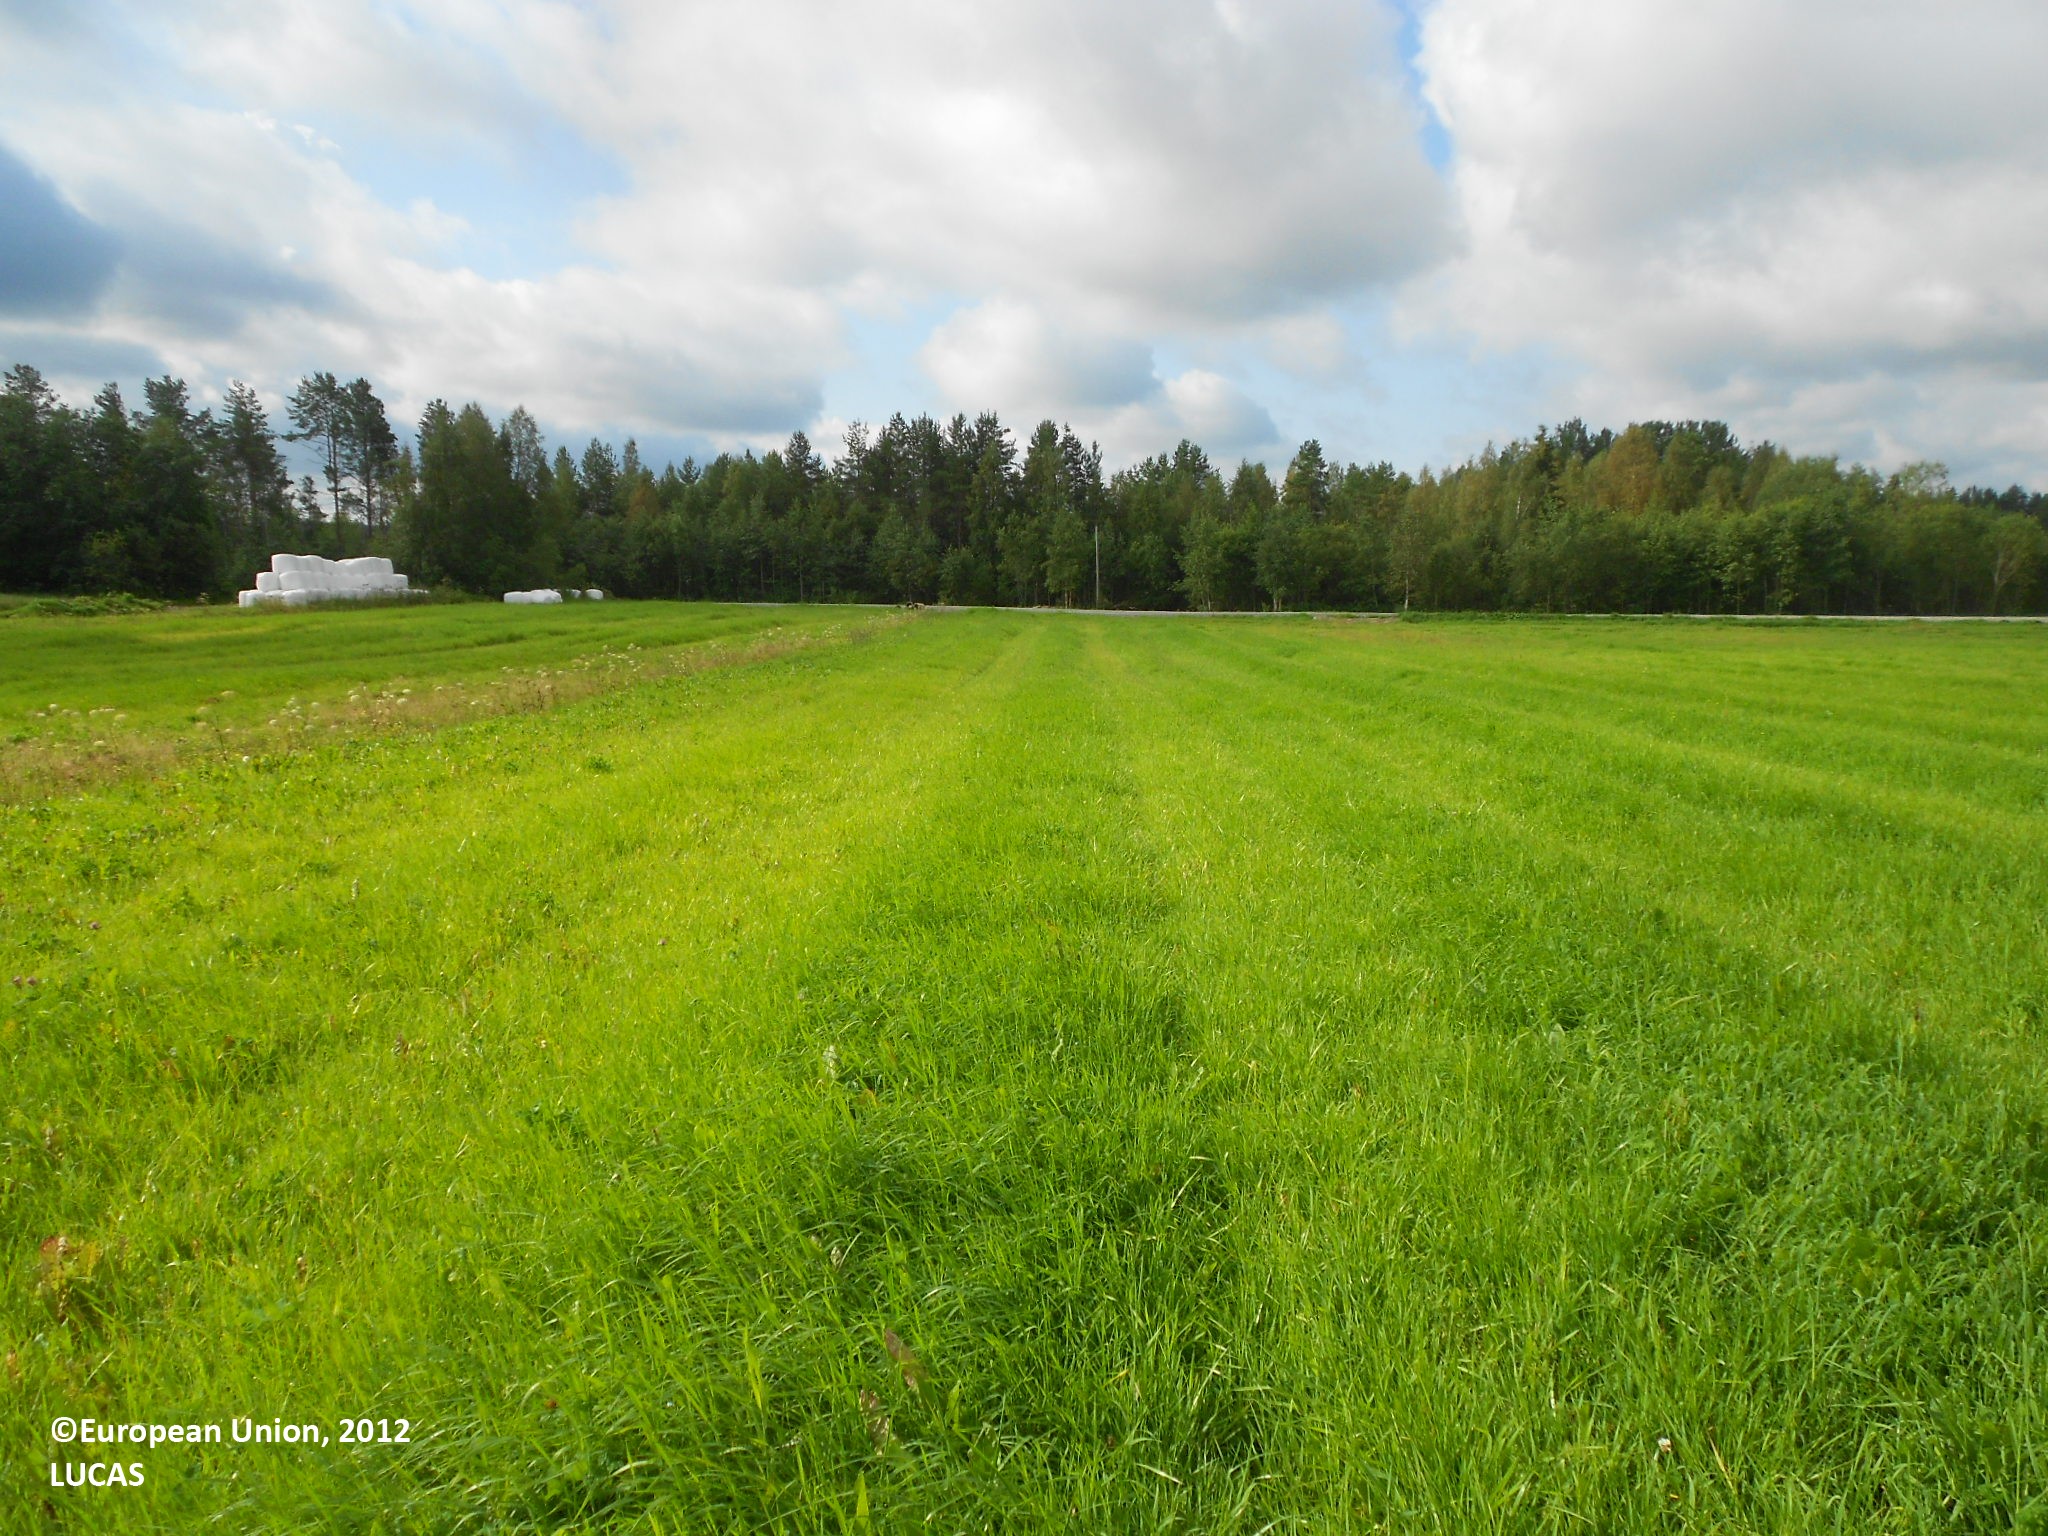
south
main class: Cropland
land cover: Temporary grasslands
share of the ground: > 75 %
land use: Agriculture (excluding fallow land and kitchen gardens)
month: August
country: FI
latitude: 63.7035
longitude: 28.6642
